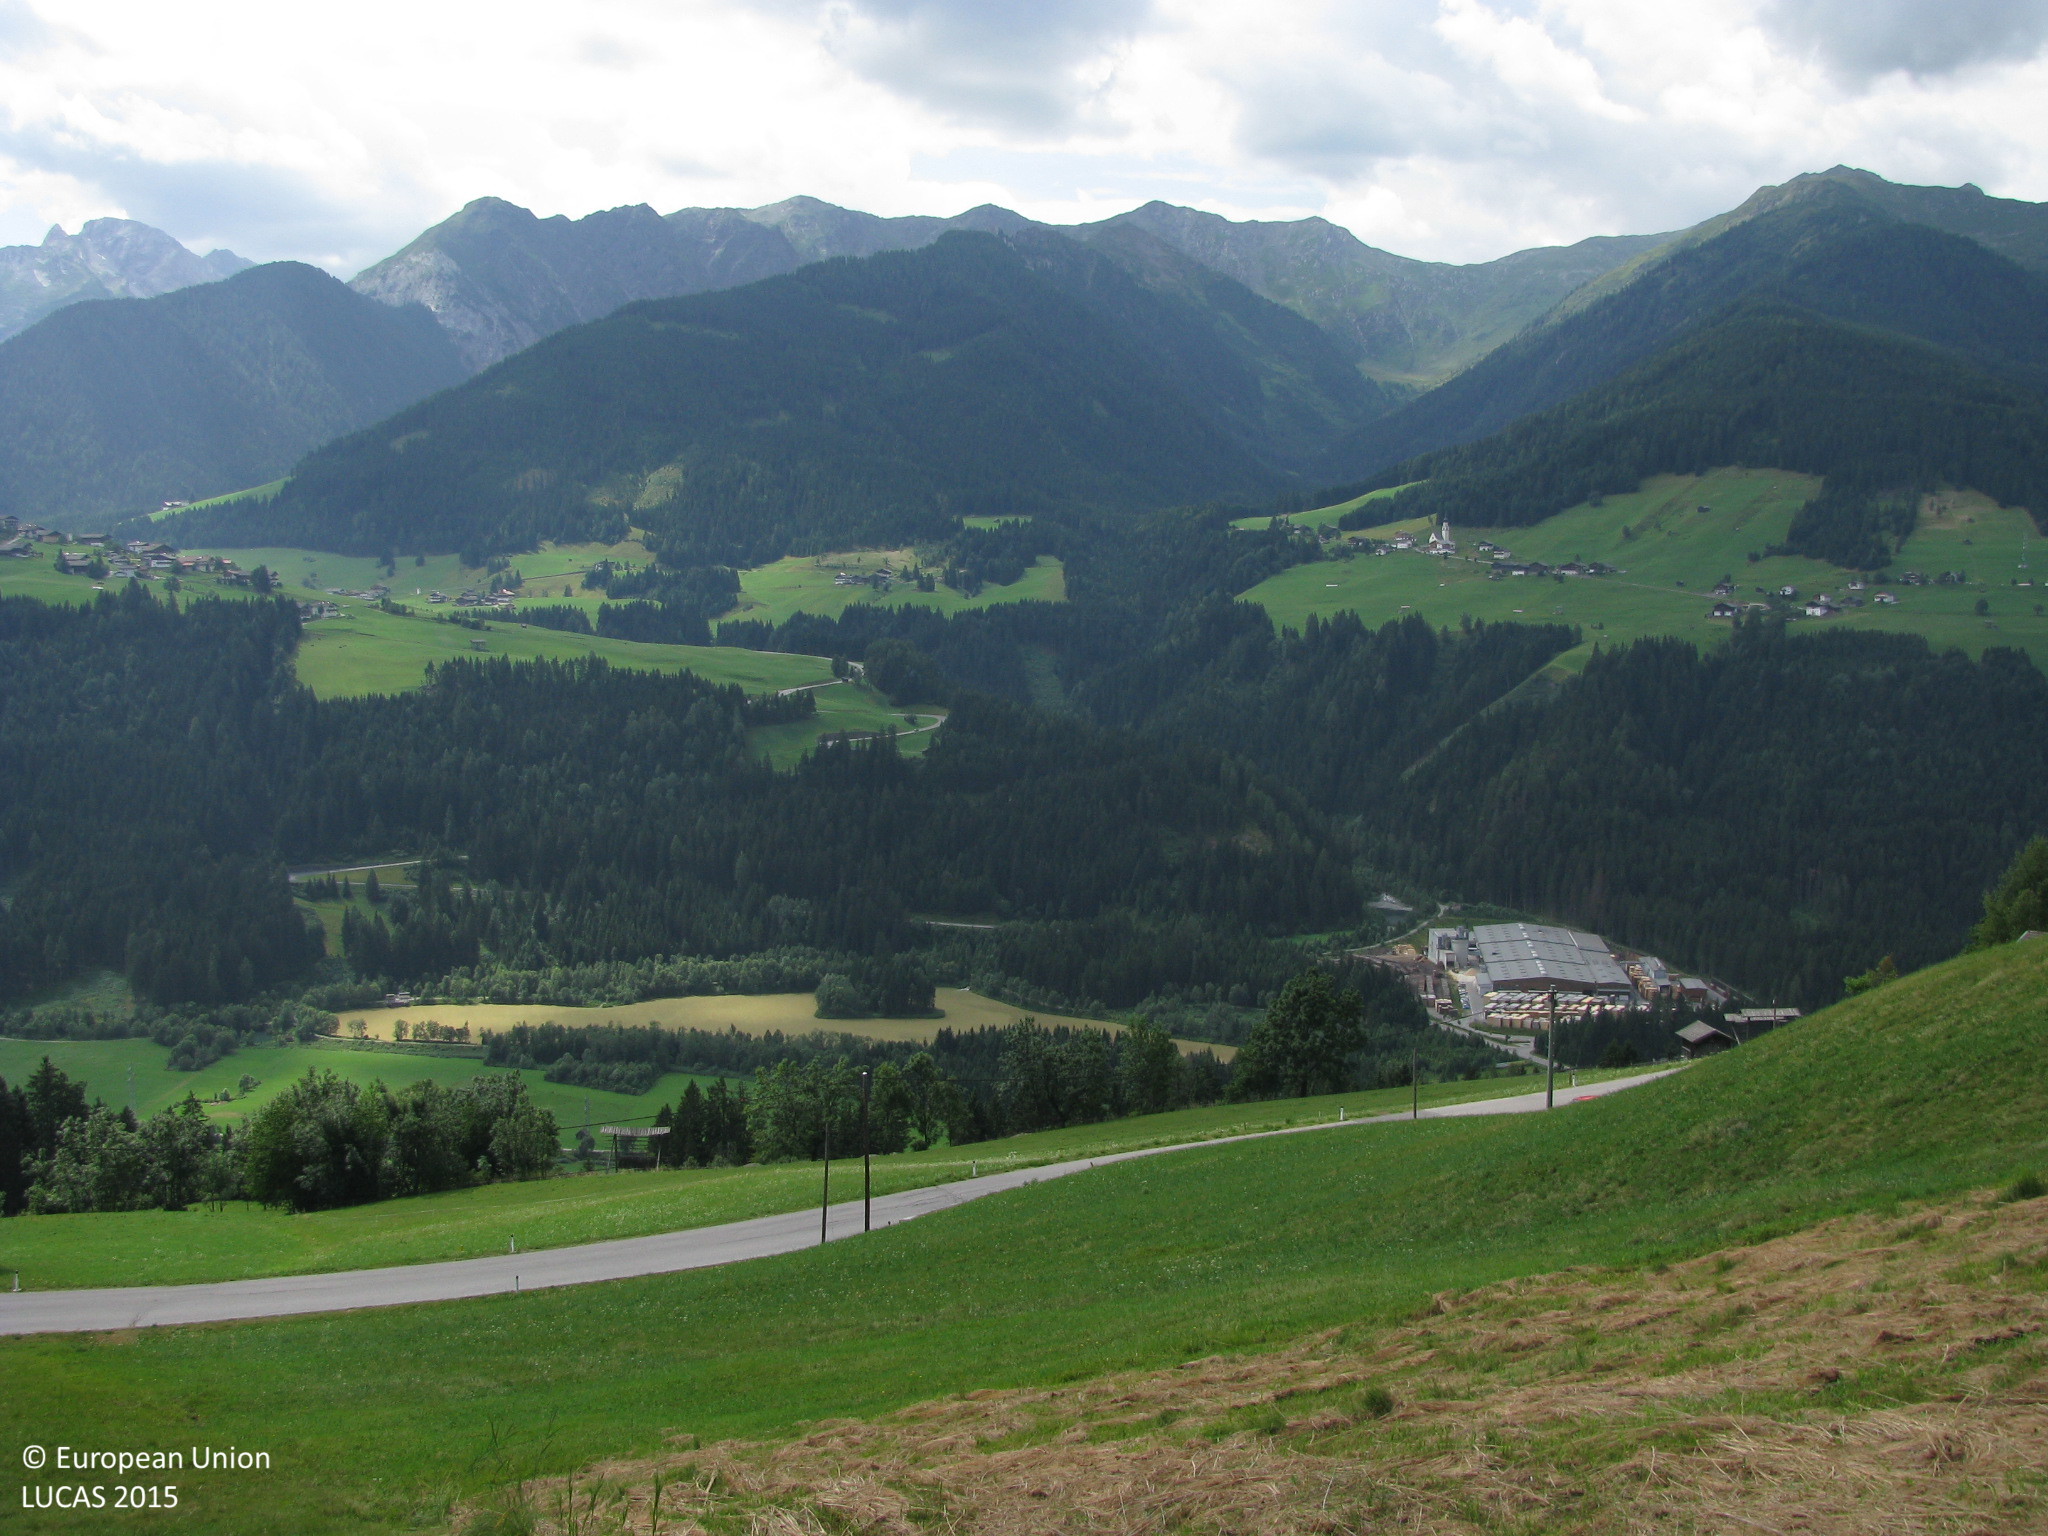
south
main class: Grassland
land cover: Grassland without tree/shrub cover
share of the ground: > 75 %
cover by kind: herbaceous plants 100 %
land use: Agriculture (excluding fallow land and kitchen gardens)
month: July
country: AT
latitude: 46.7551
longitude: 12.4719
